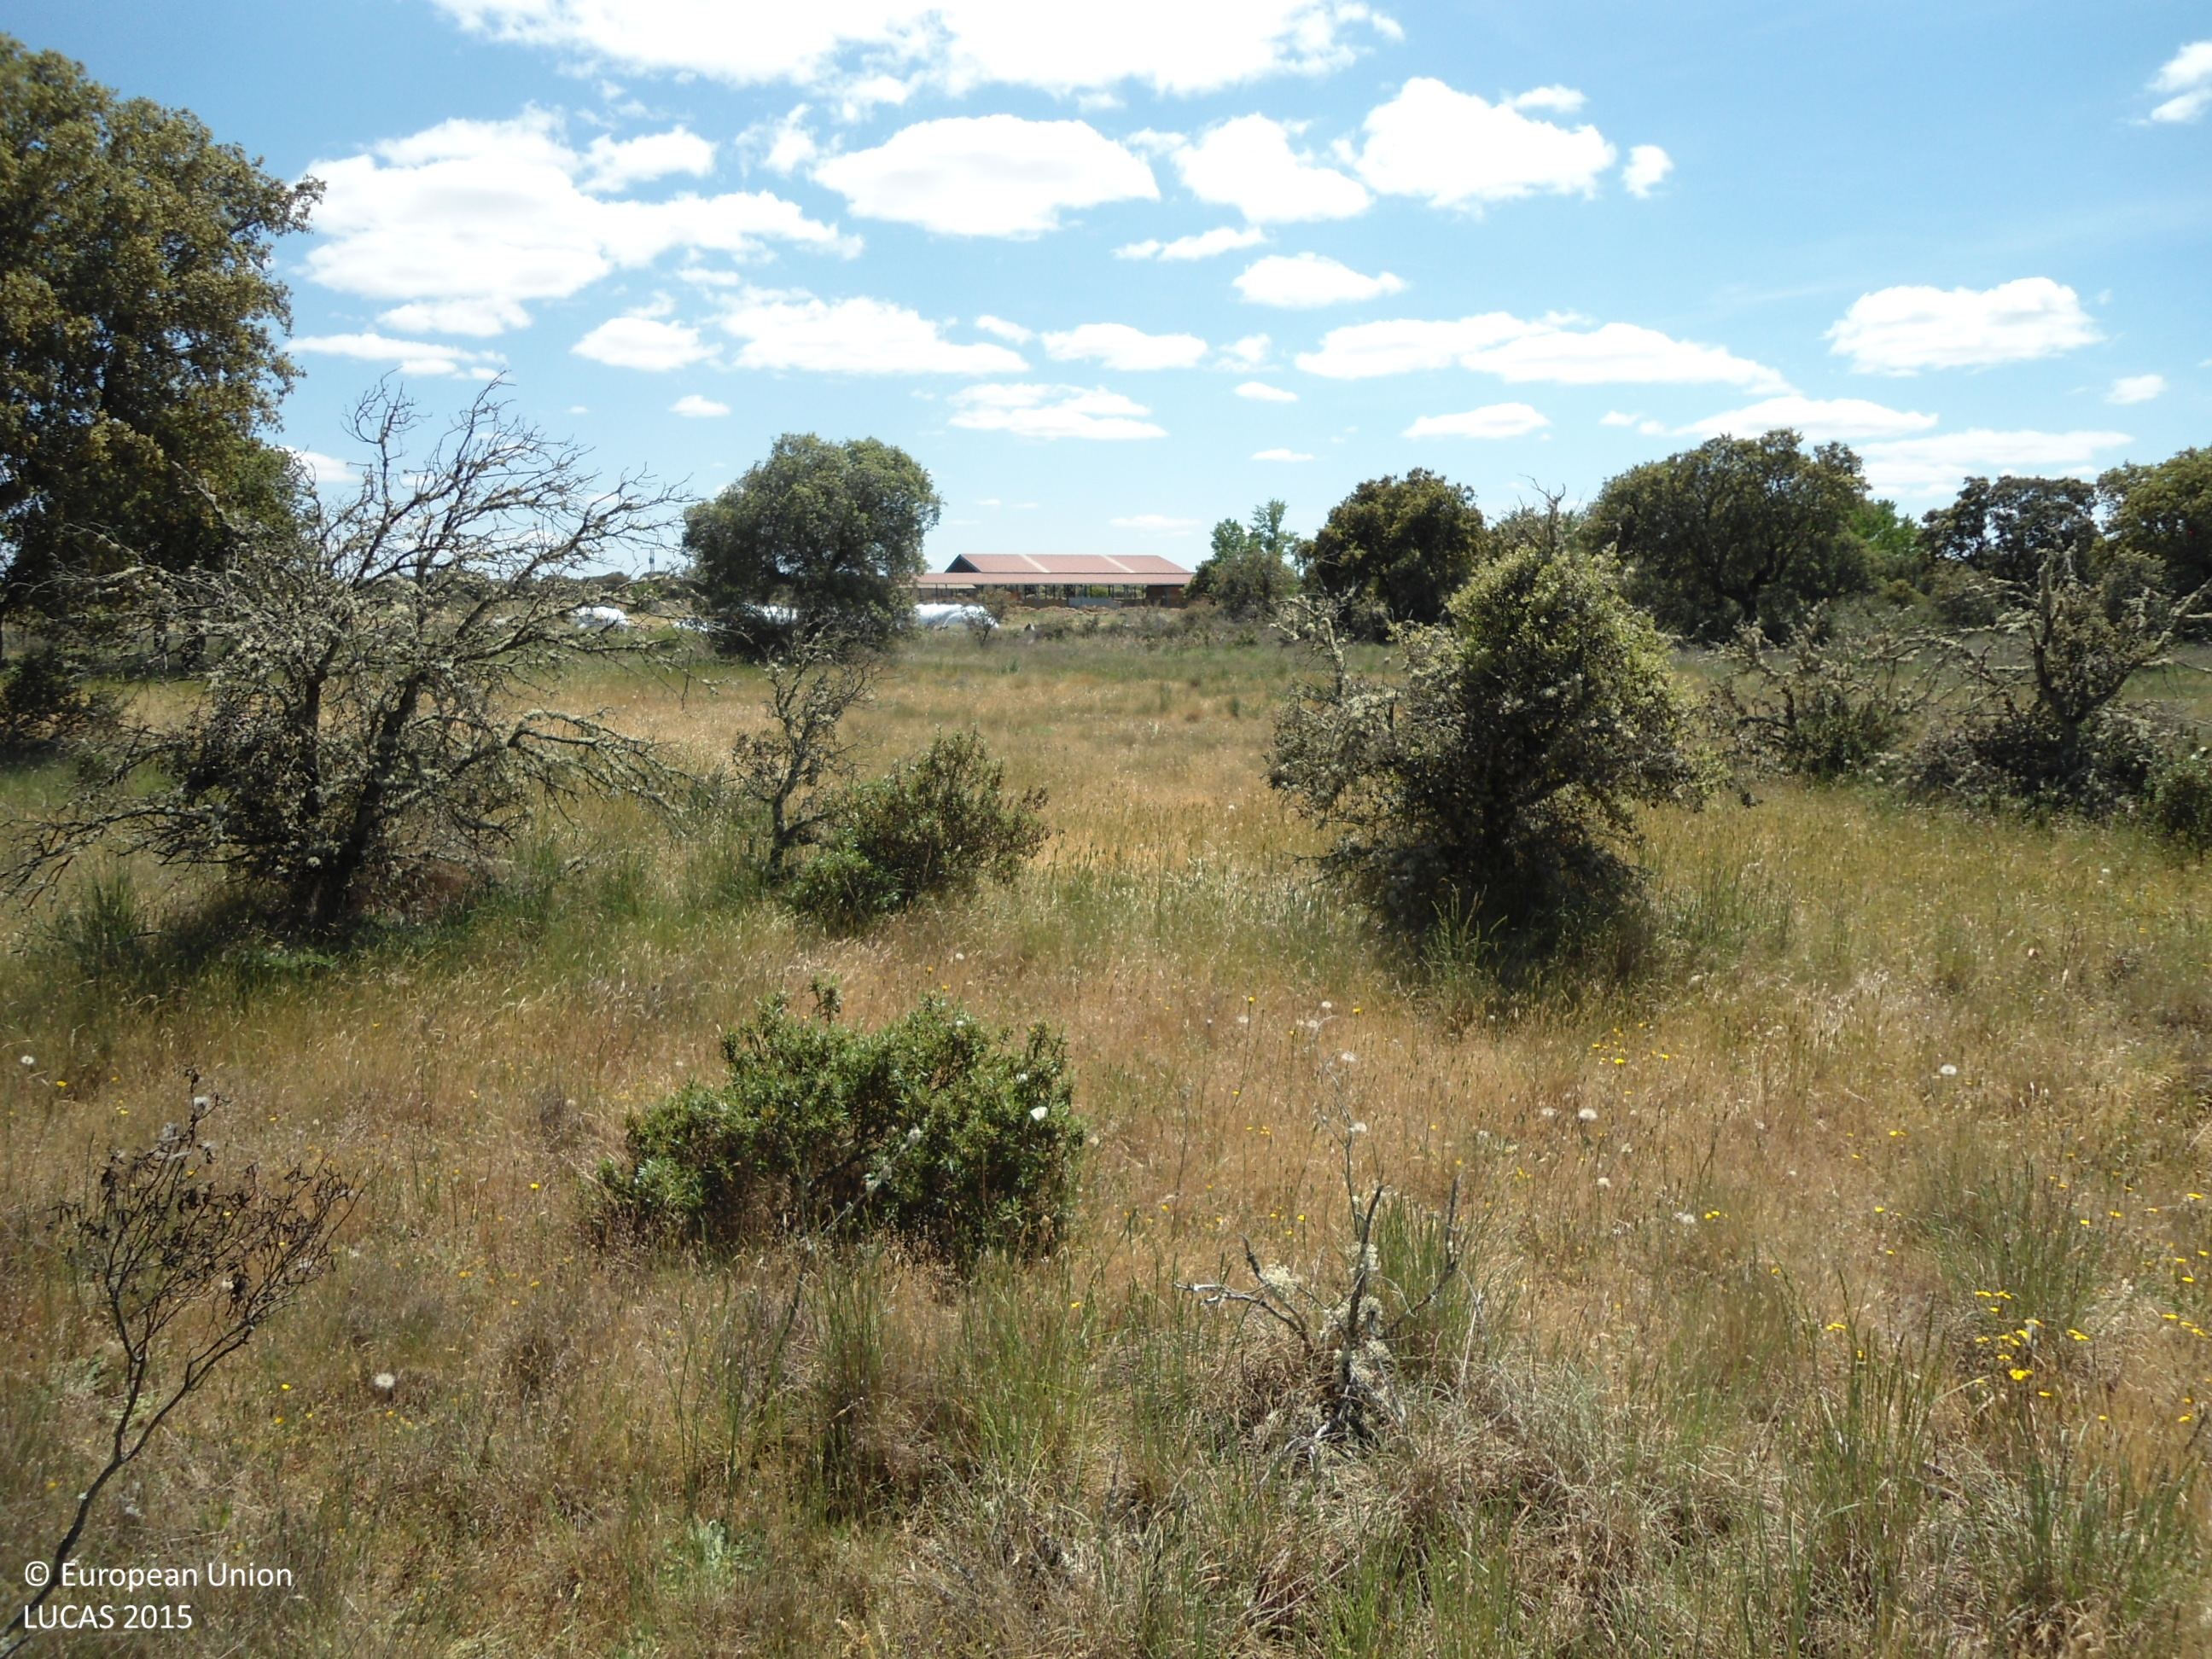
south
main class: Woodland
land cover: Broadleaved woodland
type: broadleaved evergreen forest
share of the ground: 50 - 75 %
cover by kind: broadleaved forest trees 60 %, shrubs 25 %, herbaceous plants 15 %
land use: Forestry
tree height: > 5 m
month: May
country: ES
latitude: 41.9385
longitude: -5.9080
